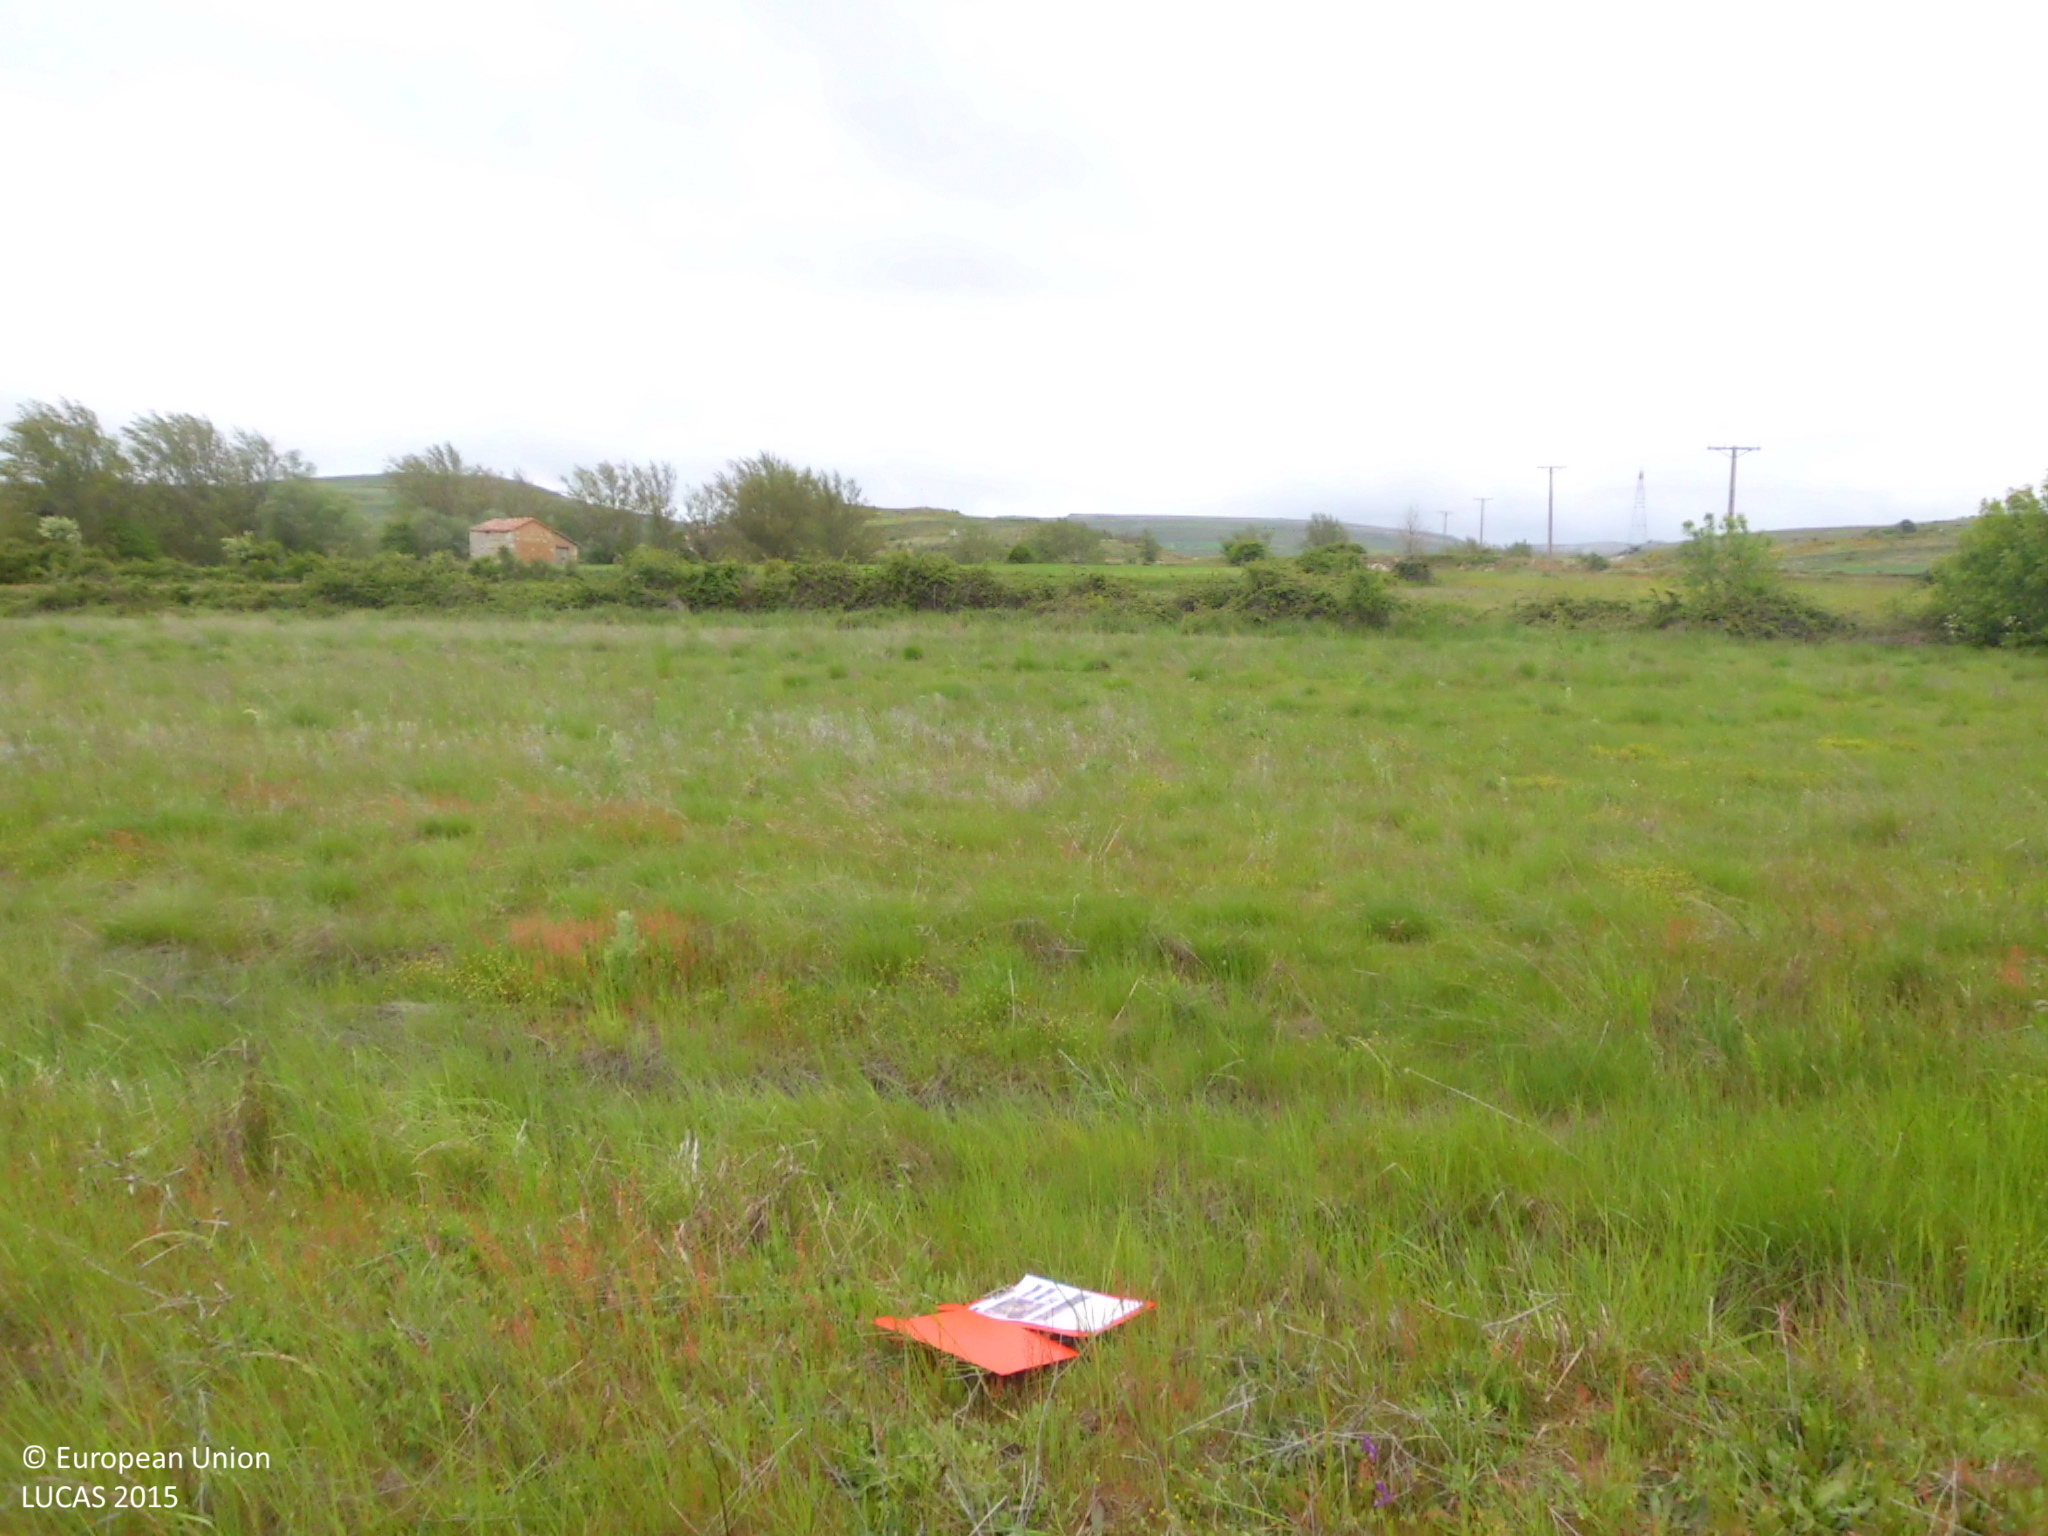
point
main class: Grassland
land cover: Grassland without tree/shrub cover
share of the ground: > 75 %
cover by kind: herbaceous plants 100 %
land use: Agriculture (excluding fallow land and kitchen gardens)
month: May
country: ES
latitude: 42.5840
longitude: -3.9208
